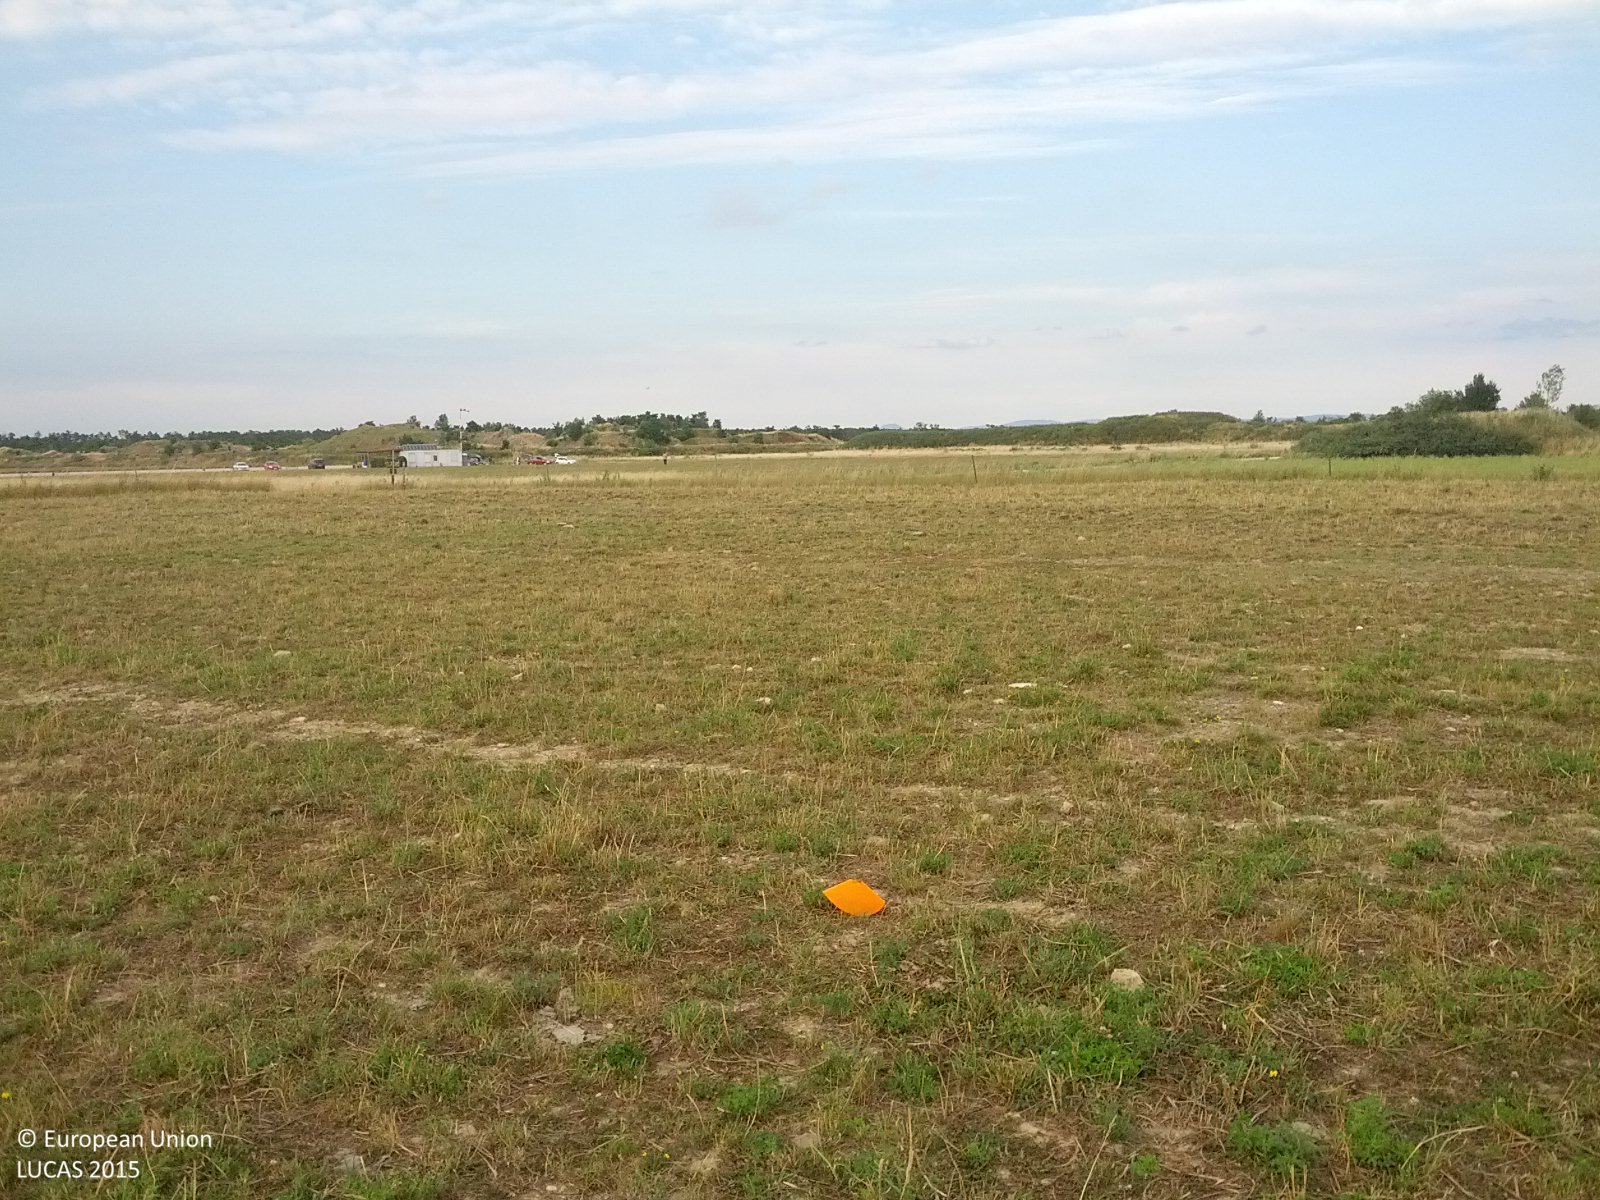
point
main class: Grassland
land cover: Grassland without tree/shrub cover
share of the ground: > 75 %
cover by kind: herbaceous plants 75 %, consolidated bare surface 25 %
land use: Agriculture (excluding fallow land and kitchen gardens)
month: June
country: AT
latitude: 48.2951
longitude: 16.6246
